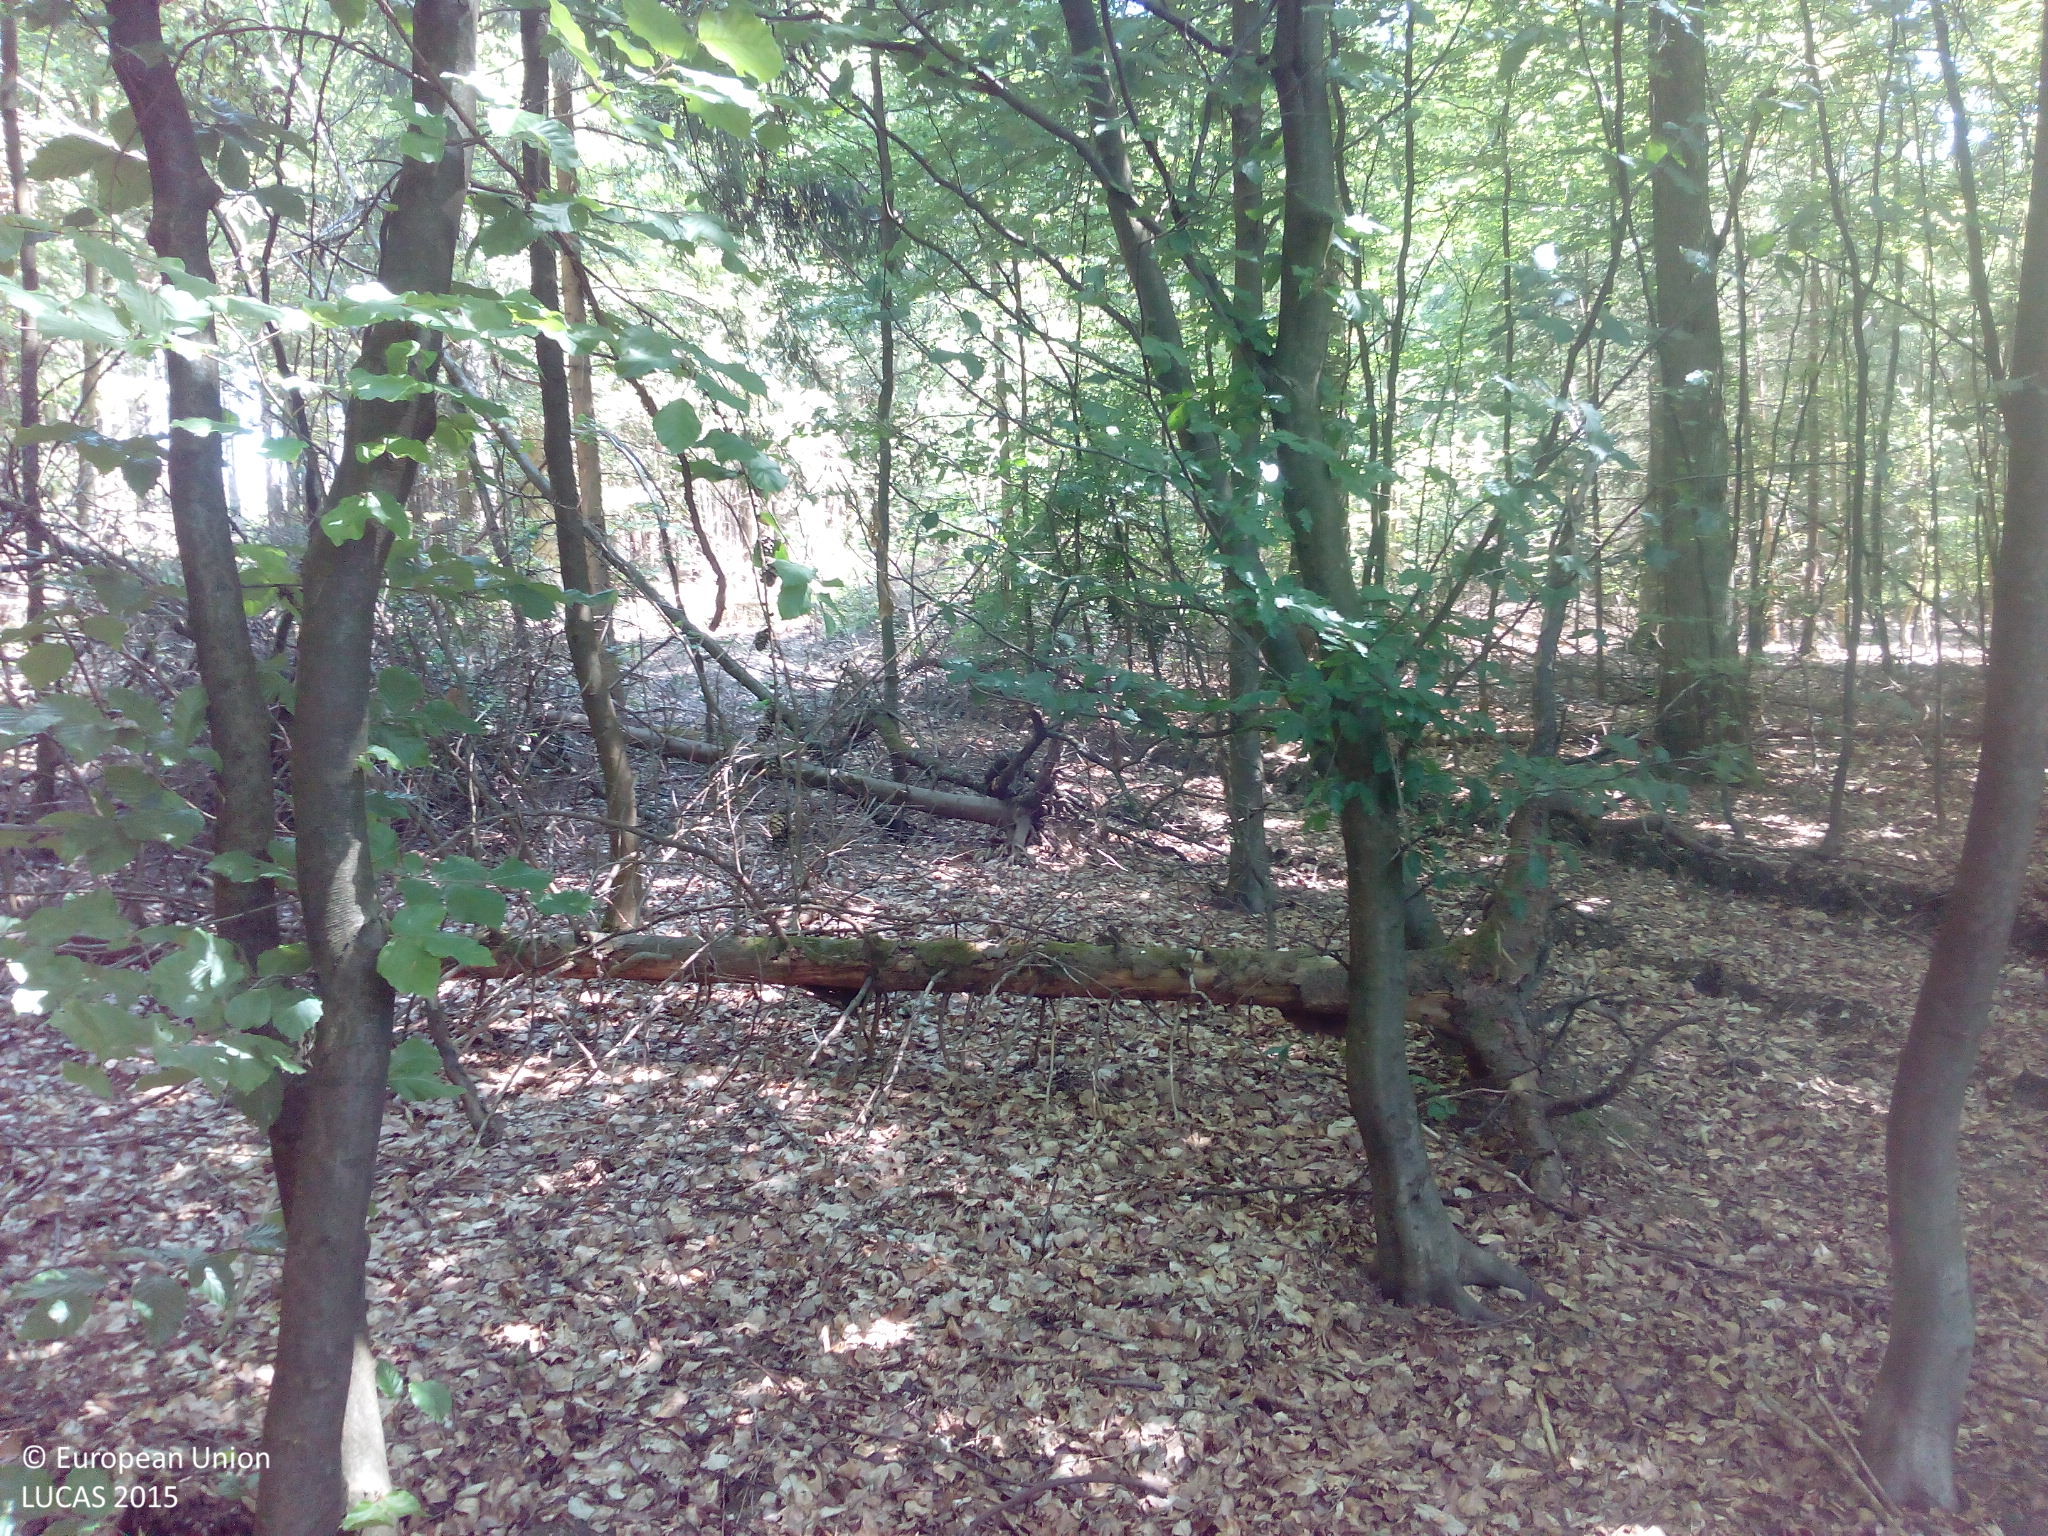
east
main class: Woodland
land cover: Broadleaved woodland
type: mesophytic deciduous forest
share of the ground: > 75 %
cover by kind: broadleaved forest trees 95 %, unconsolidated bare surface 5 %
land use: Forestry
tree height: > 5 m
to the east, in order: Broadleaved woodland; Tracks; Broadleaved woodland; Tracks; Spruce dominated coniferous woodland; Spontaneously vegetated surfaces; Spruce dominated coniferous woodland; Tracks; Spruce dominated coniferous woodland; Broadleaved woodland
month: June
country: DE
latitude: 50.1147
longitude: 8.1125
